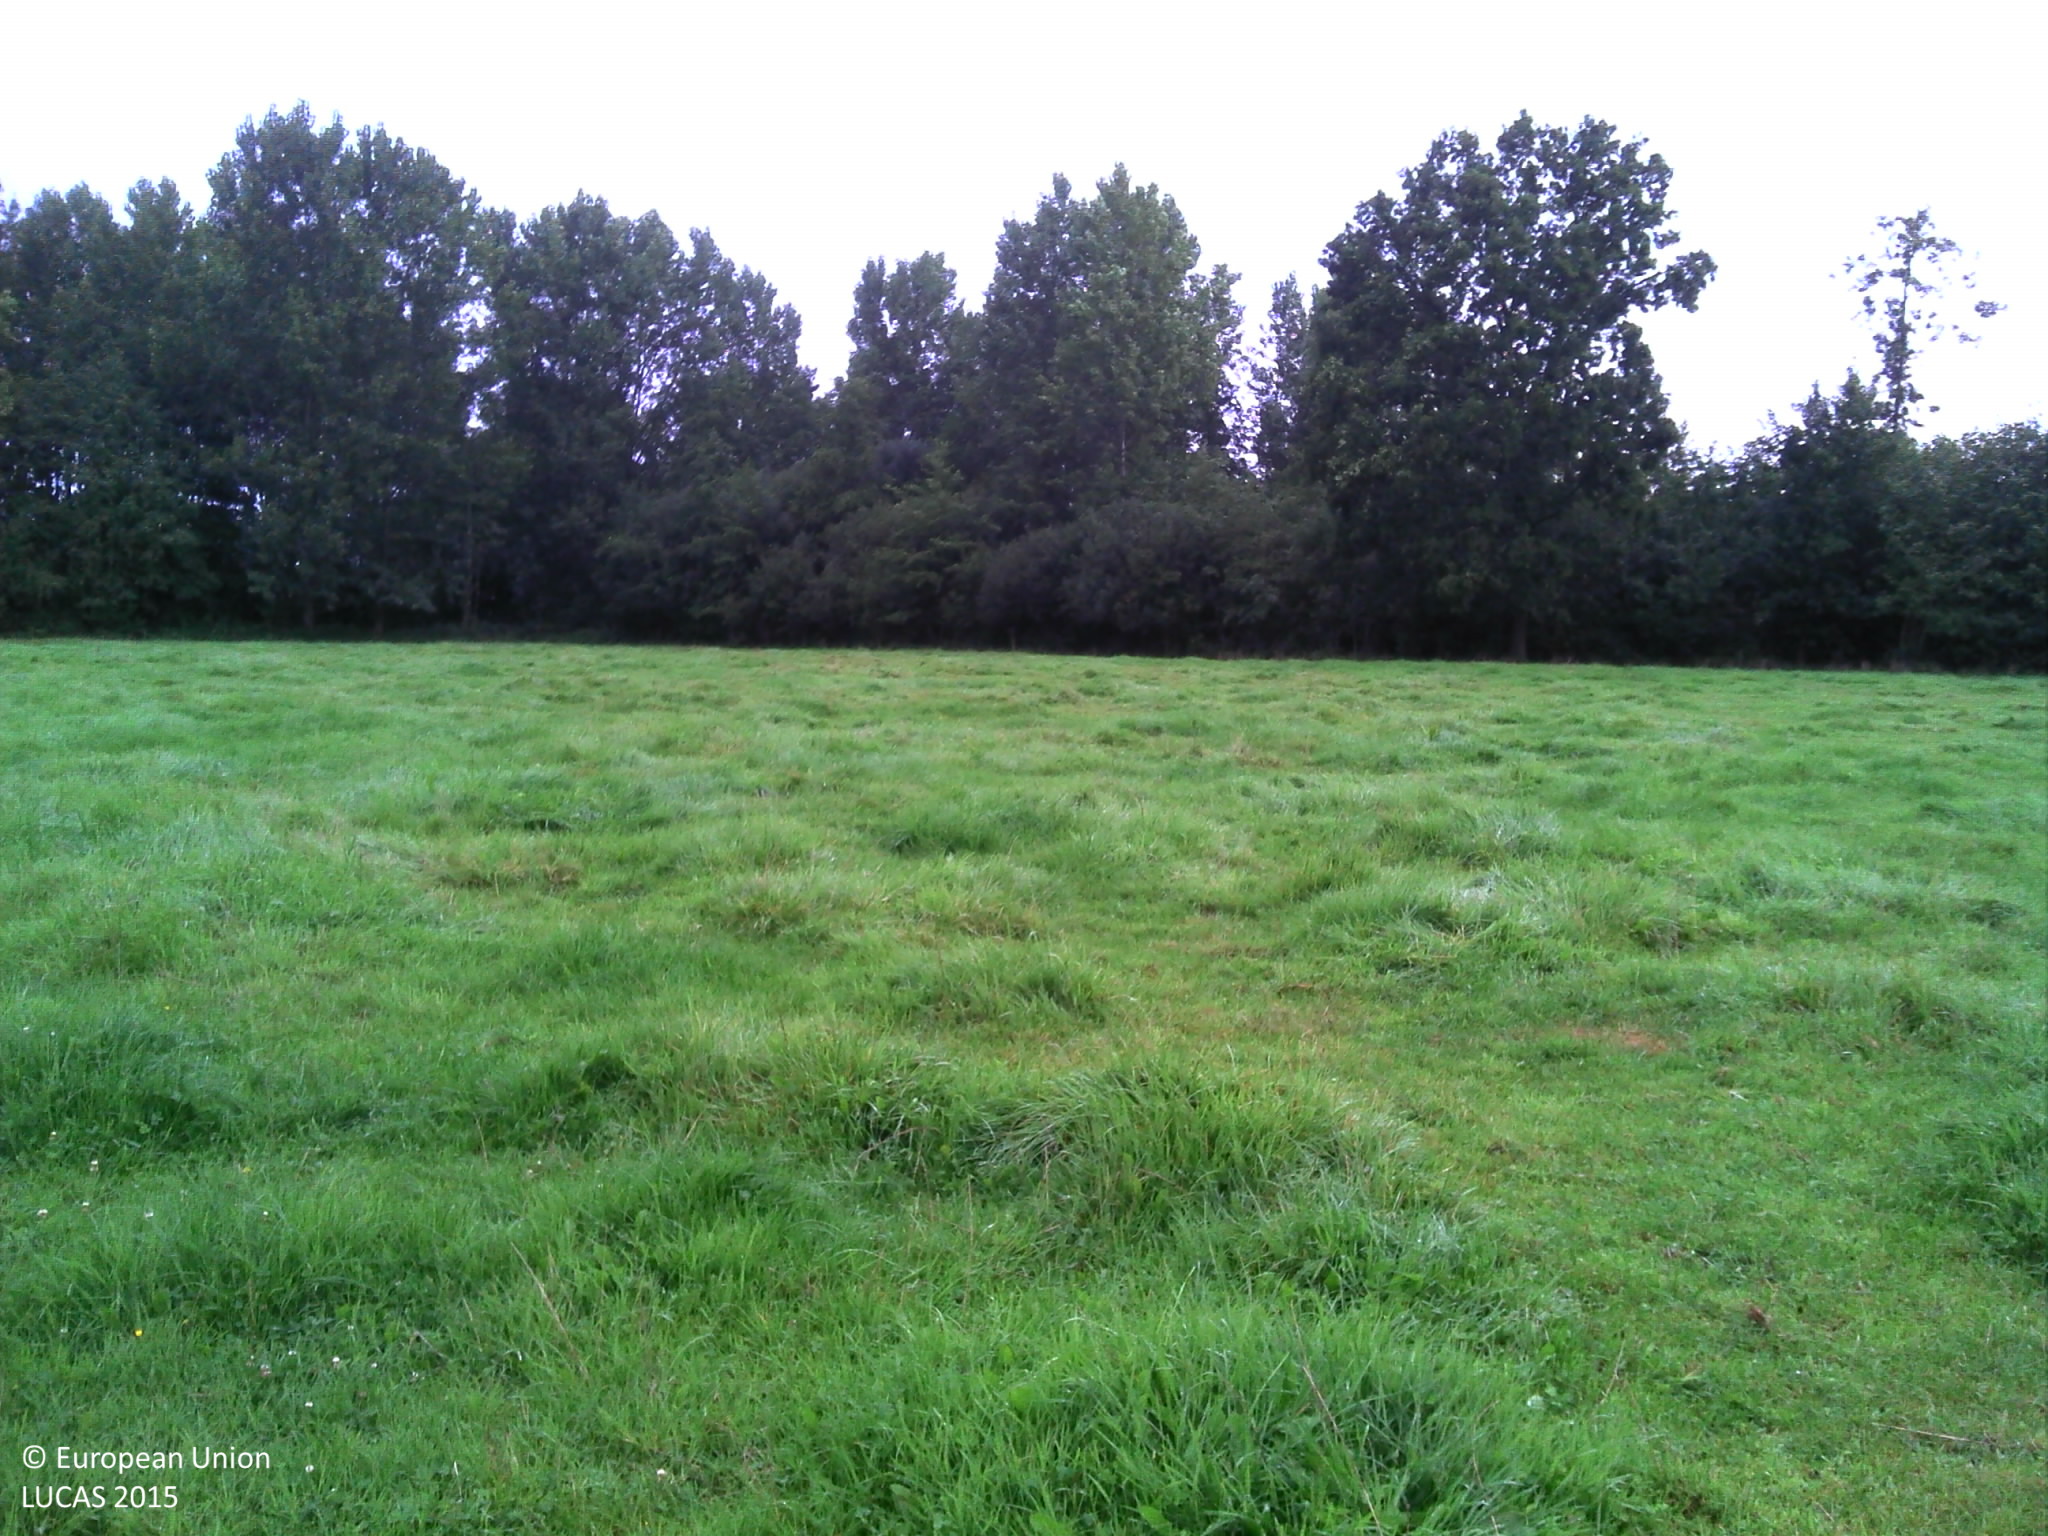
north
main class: Grassland
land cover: Grassland without tree/shrub cover
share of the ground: > 75 %
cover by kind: herbaceous plants 100 %
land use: Agriculture (excluding fallow land and kitchen gardens)
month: September
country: BE
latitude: 51.4312
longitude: 4.7175
